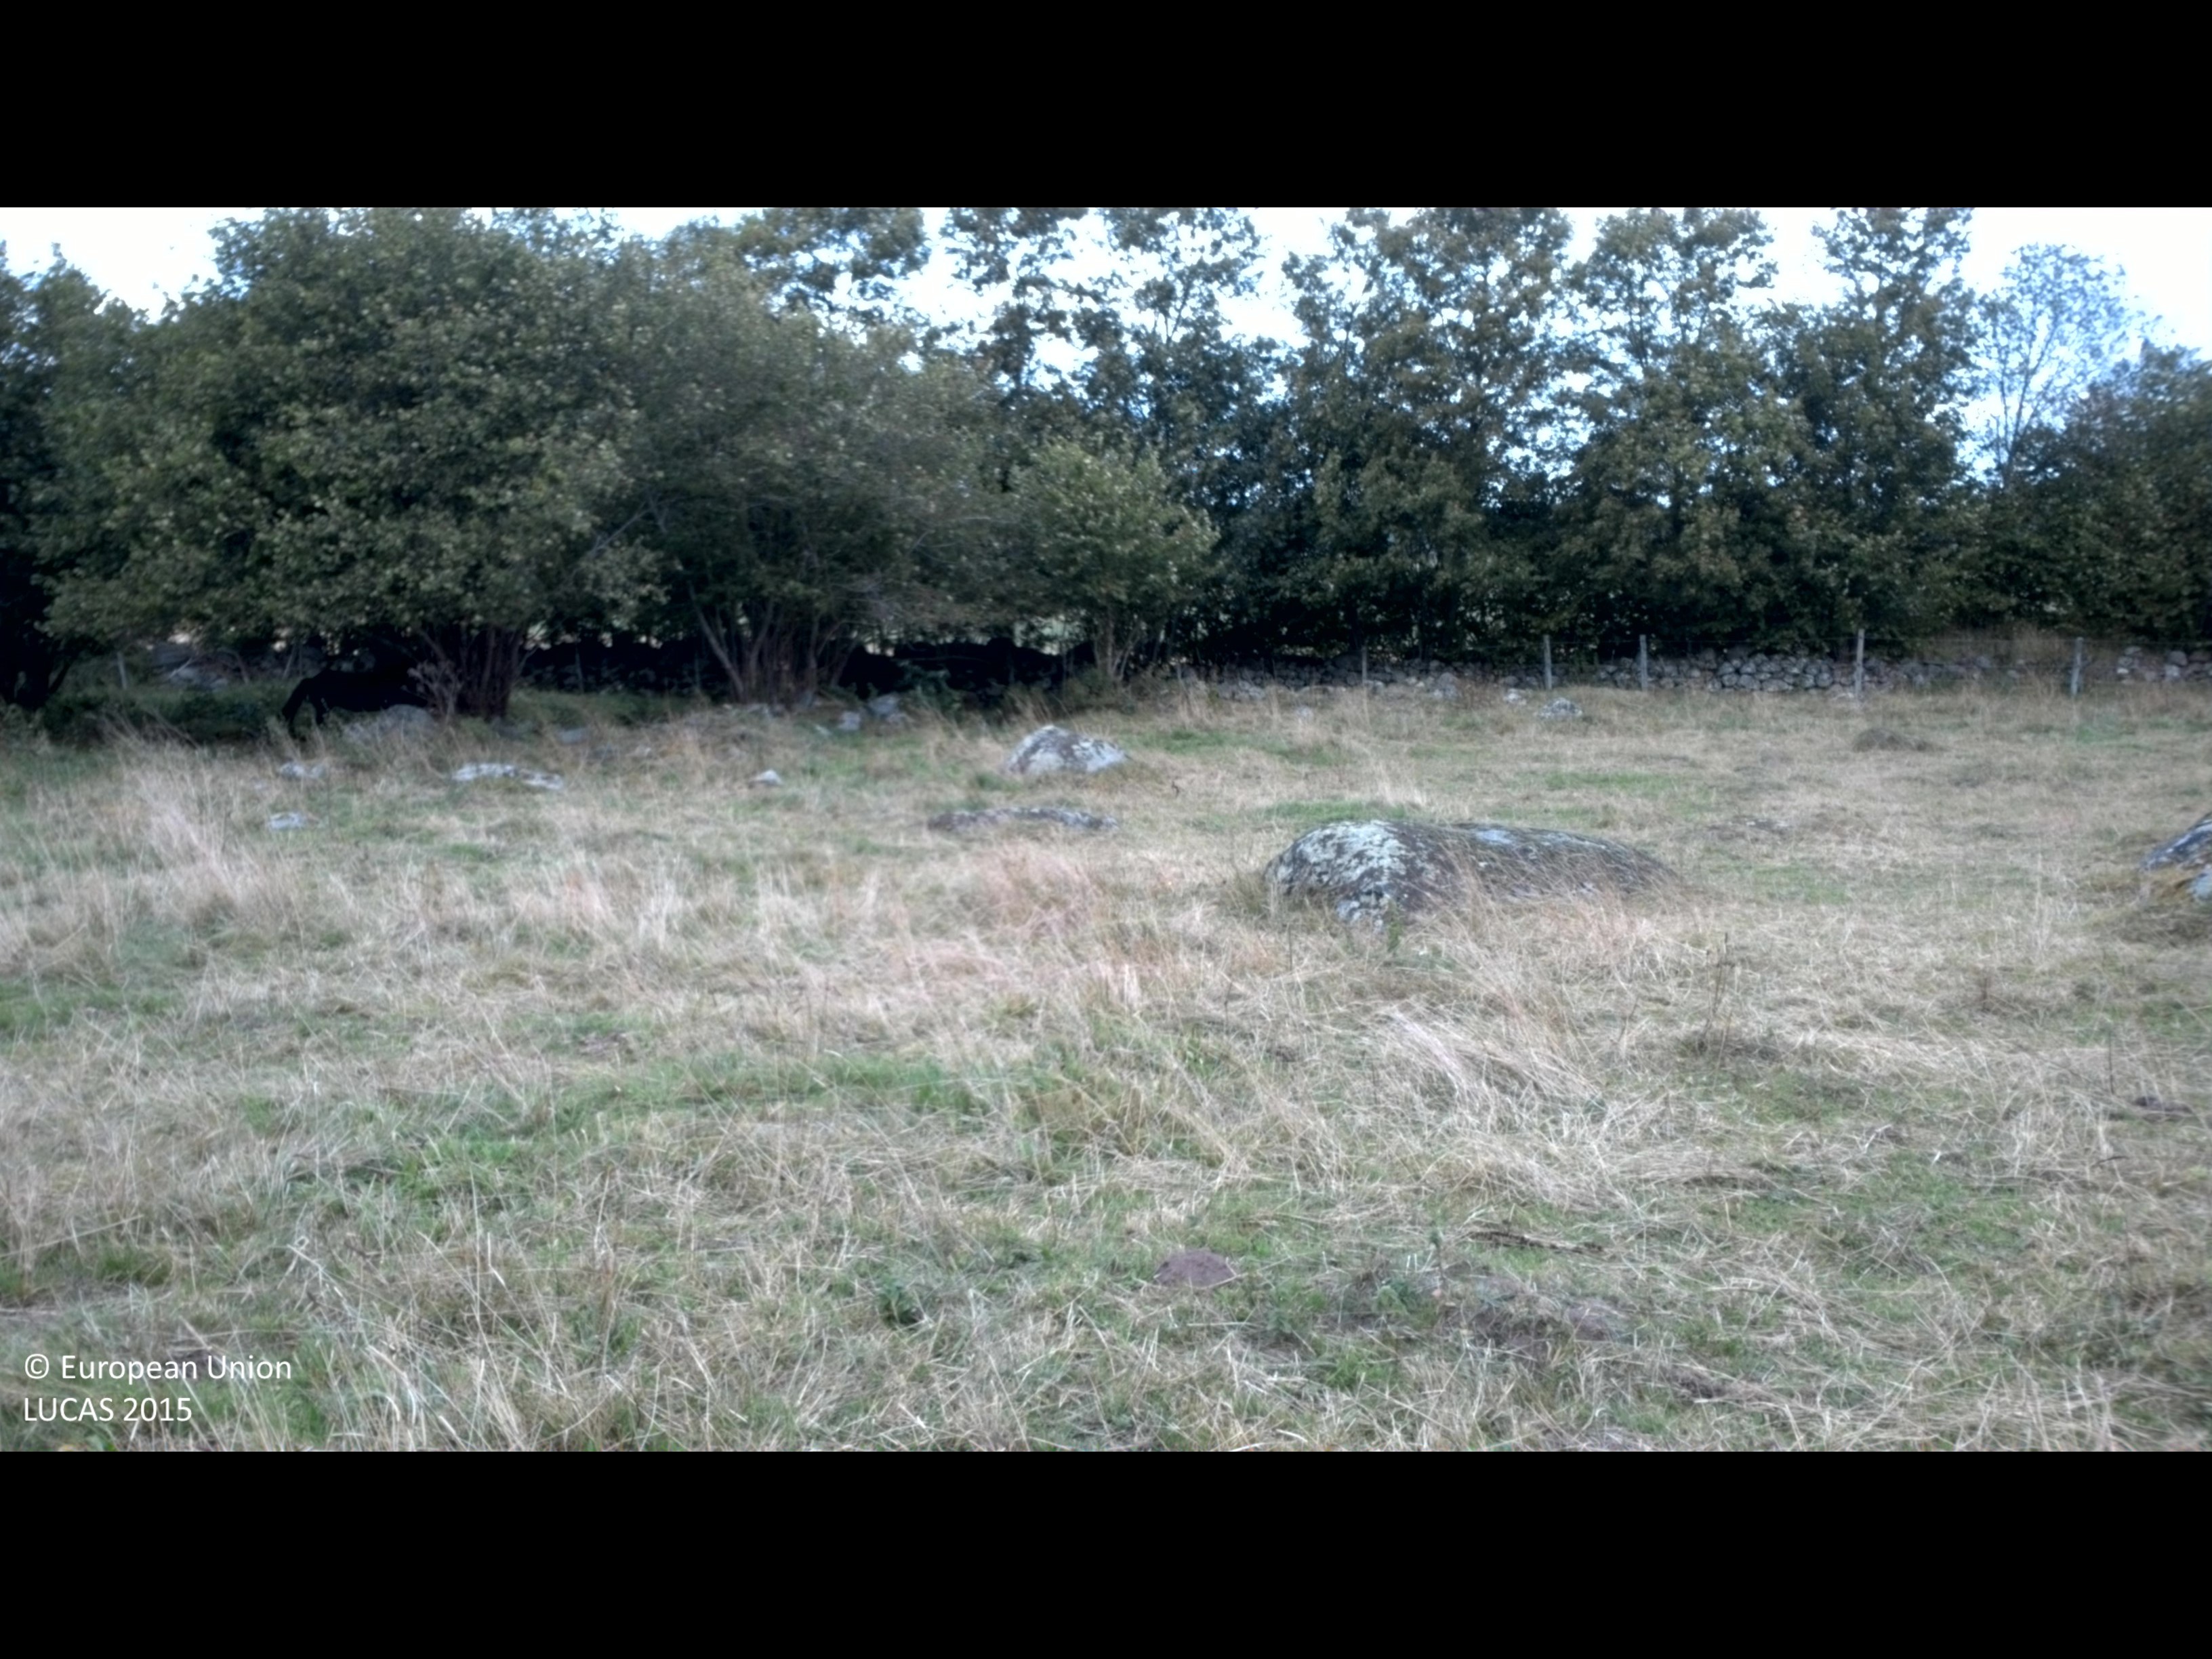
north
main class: Grassland
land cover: Grassland without tree/shrub cover
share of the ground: > 75 %
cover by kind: herbaceous plants 100 %
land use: Agriculture (excluding fallow land and kitchen gardens)
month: September
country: SE
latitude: 56.1244
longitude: 14.0354
